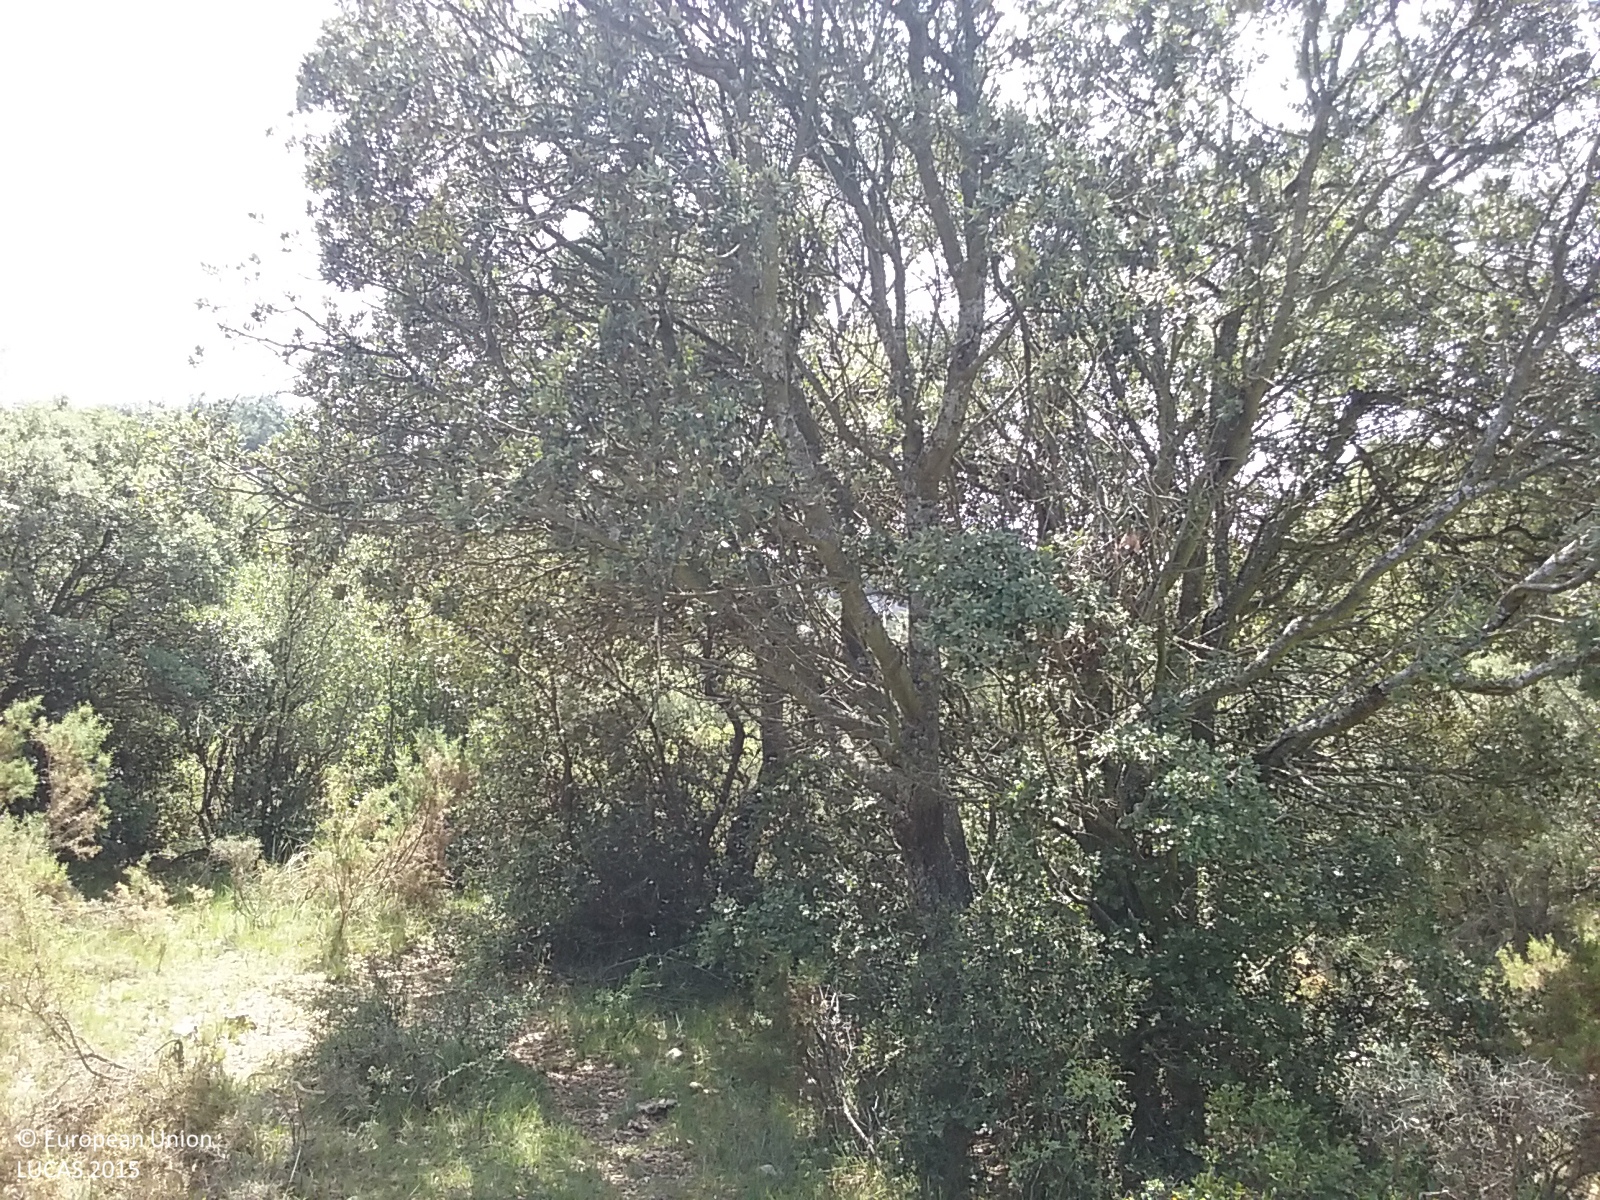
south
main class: Woodland
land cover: Broadleaved woodland
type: broadleaved evergreen forest
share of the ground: 50 - 75 %
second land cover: Shrubland without tree cover
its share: 25 - 50 %
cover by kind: broadleaved forest trees 60 %, shrubs 20 %, herbaceous plants 20 %
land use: Forestry
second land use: Agriculture (excluding fallow land and kitchen gardens)
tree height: > 5 m
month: August
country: ES
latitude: 40.4183
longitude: -0.1056
